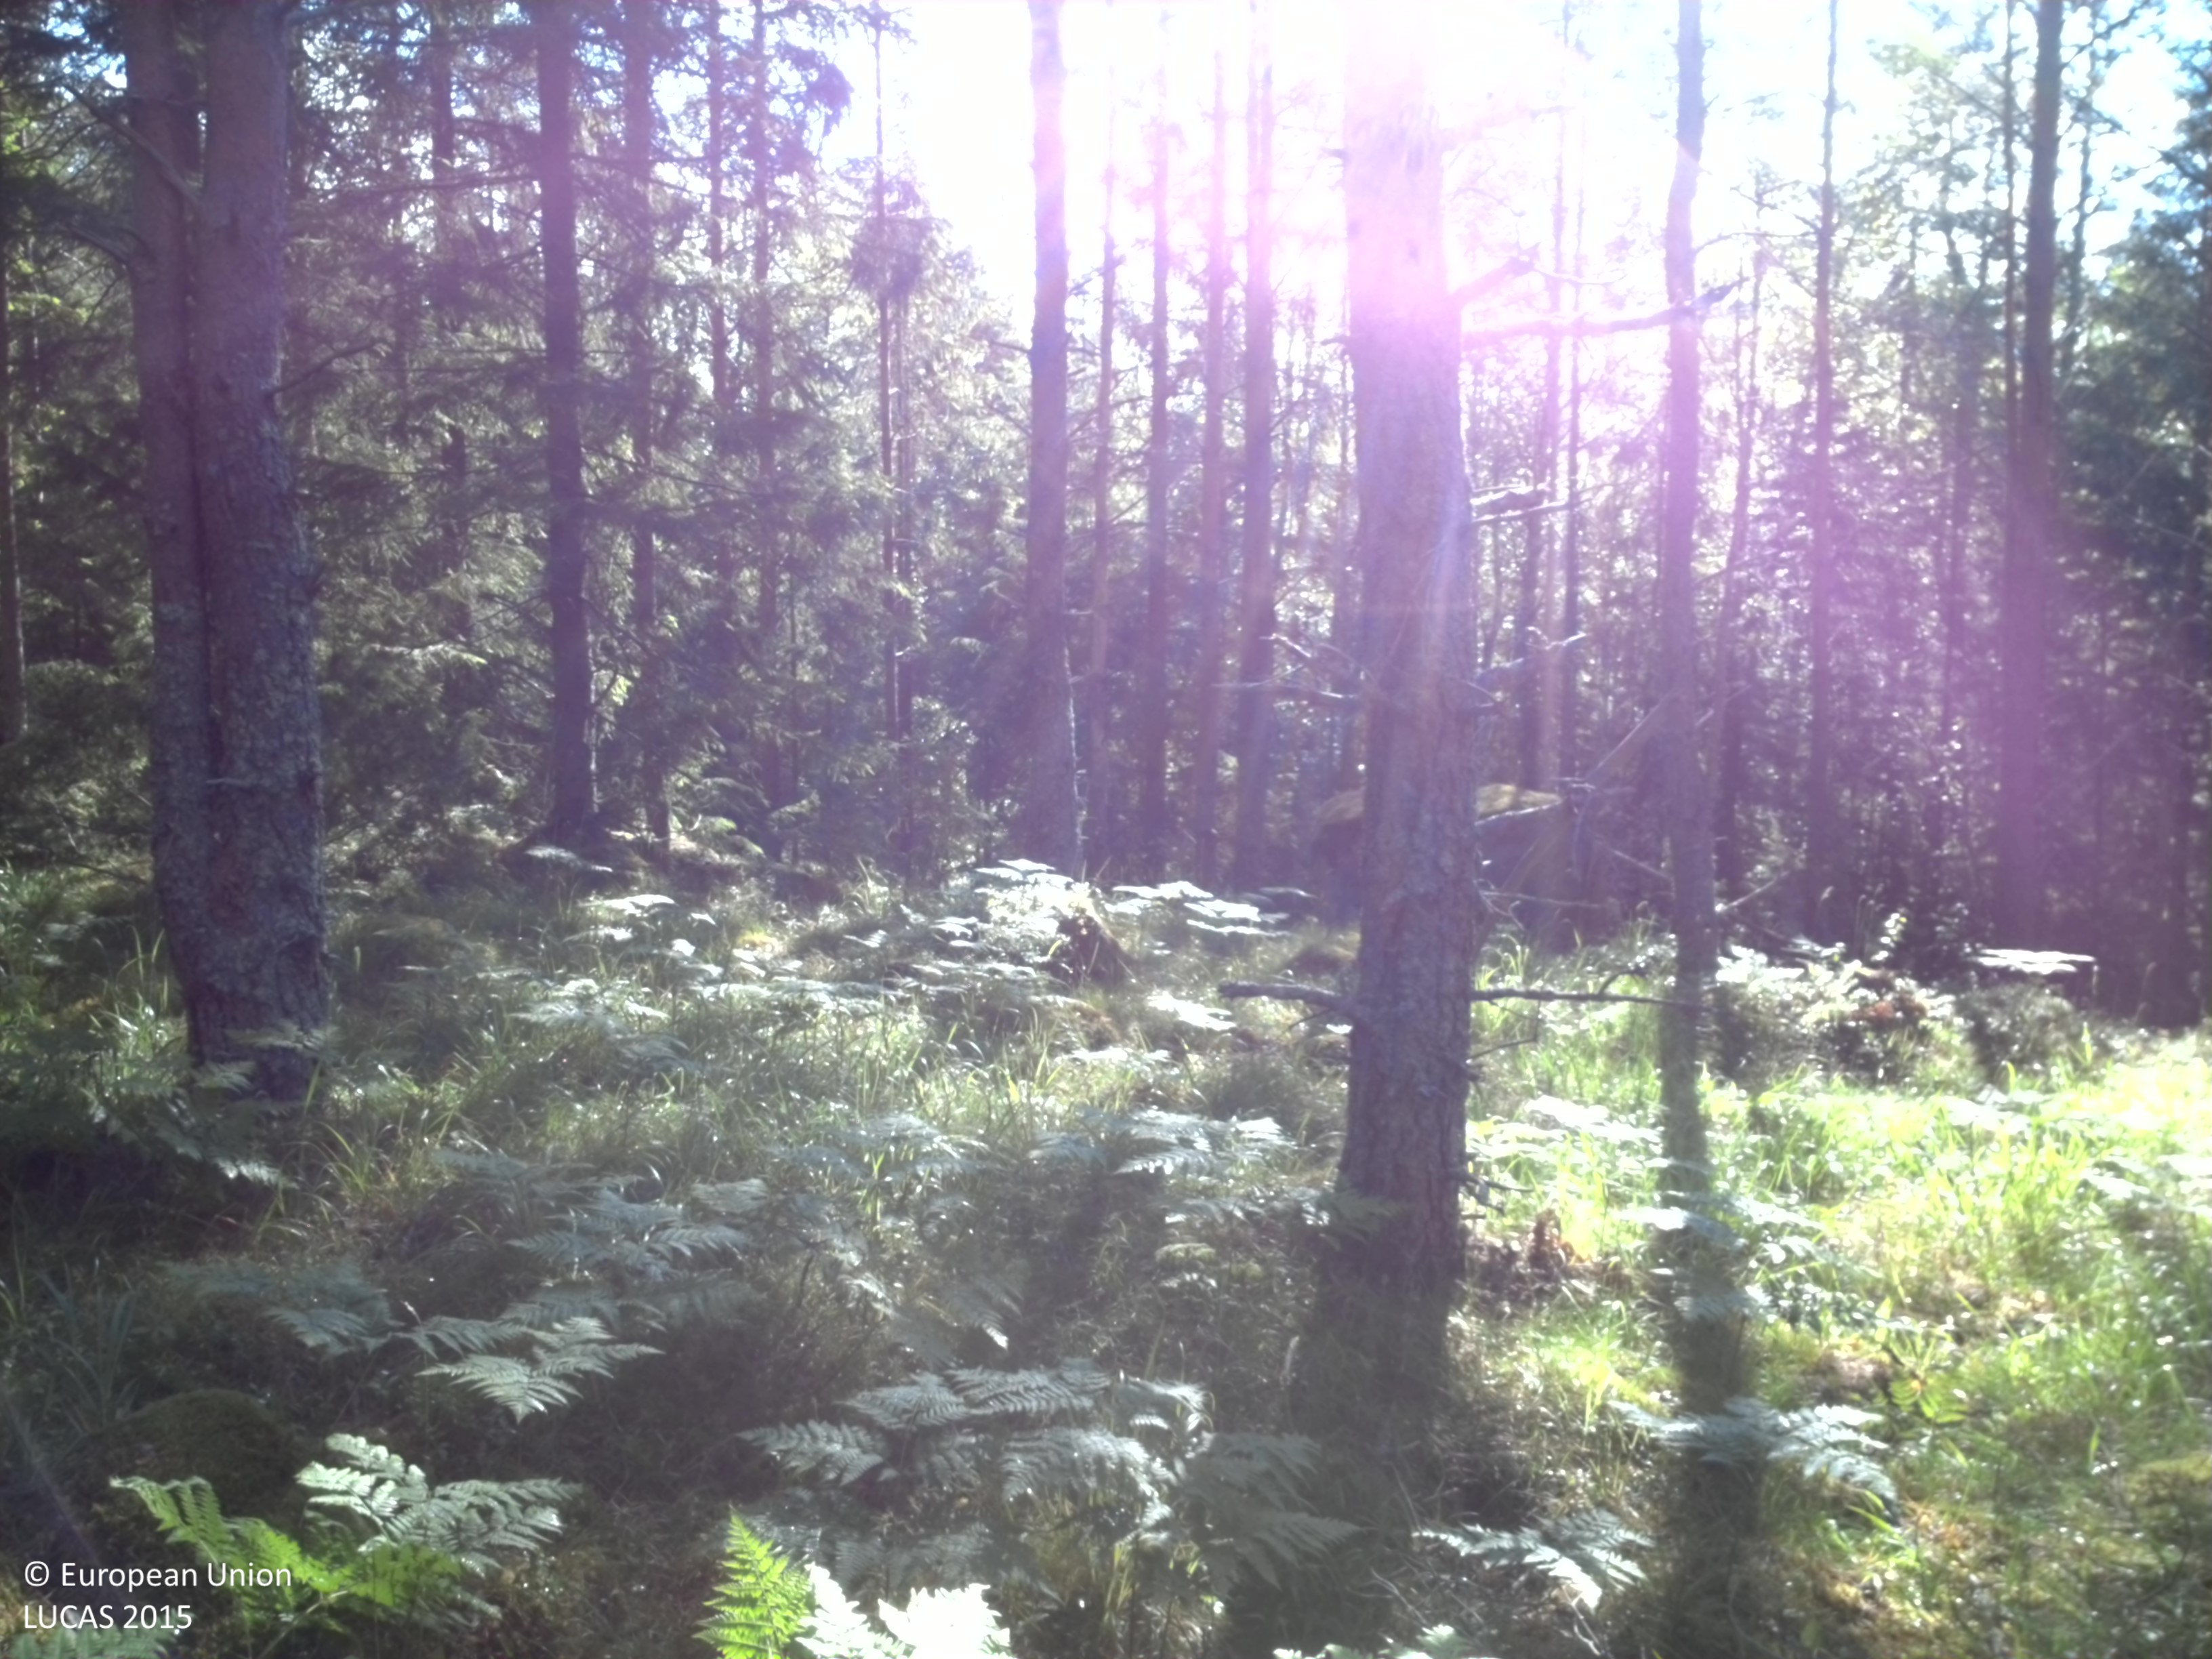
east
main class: Woodland
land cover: Pine dominated coniferous woodland
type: boreal forest
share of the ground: 25 - 50 %
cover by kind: herbaceous plants 55 %, coniferous forest trees 30 %, lichens and mosses 10 %, broadleaved forest trees 5 %
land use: Forestry
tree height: > 5 m
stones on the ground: 10 - 25 %
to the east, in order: Pine dominated coniferous woodland; Broadleaved woodland; Pine dominated coniferous woodland; Spruce dominated mixed woodland; Ditches and canals
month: June
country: SE
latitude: 58.6126
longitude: 15.4852
